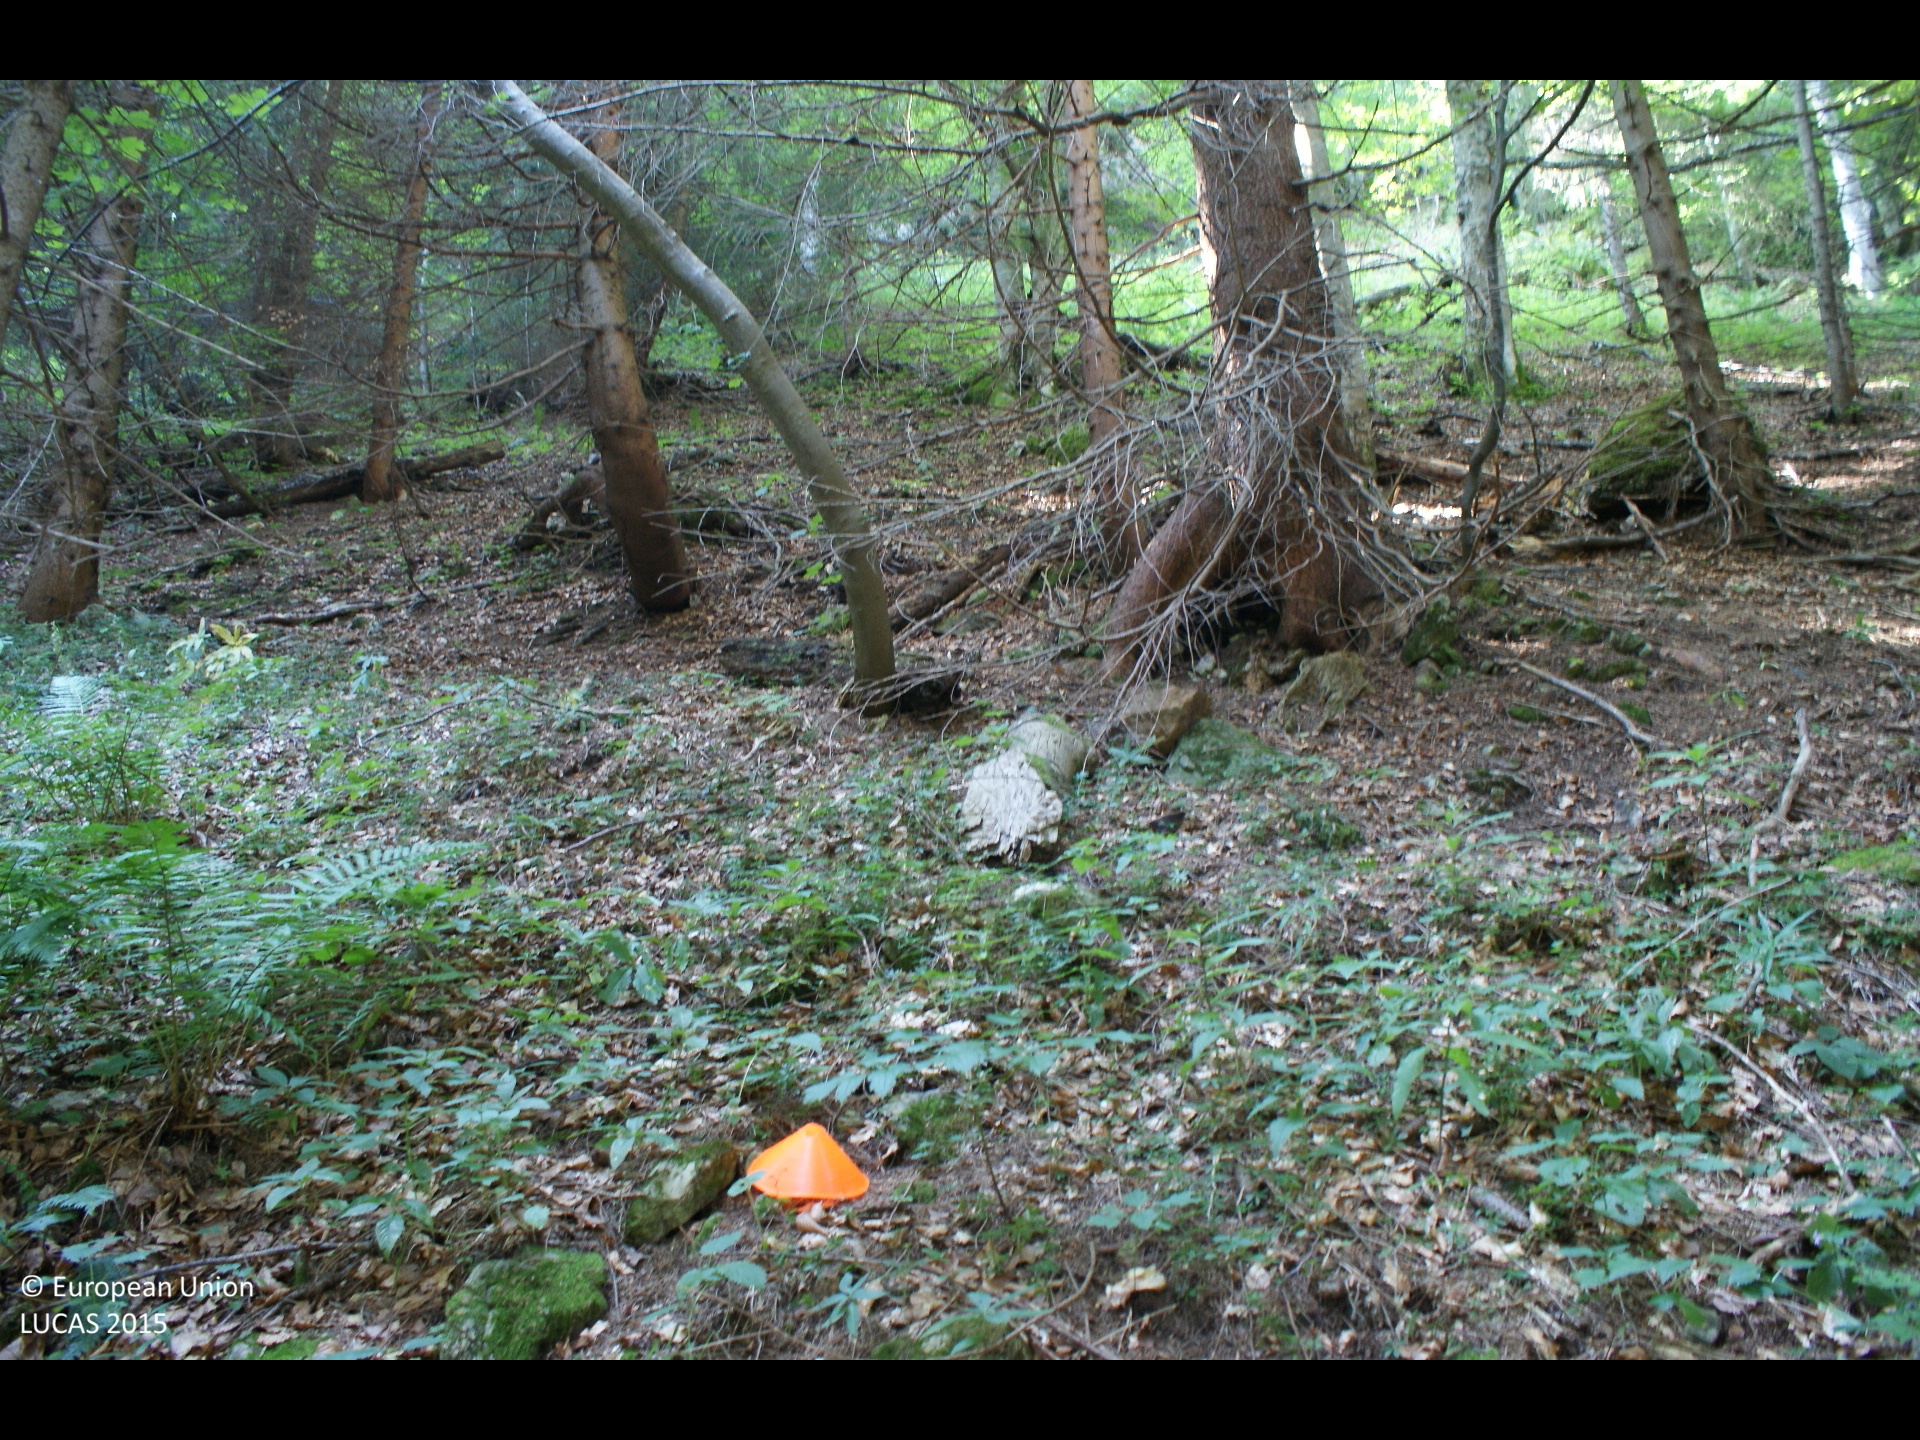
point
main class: Woodland
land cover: Spruce dominated mixed woodland
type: mountainous beech forest
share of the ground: > 75 %
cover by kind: coniferous forest trees 65 %, broadleaved forest trees 25 %, herbaceous plants 5 %, lichens and mosses 5 %
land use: Forestry
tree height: > 5 m
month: August
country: AT
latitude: 47.6228
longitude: 15.3899
